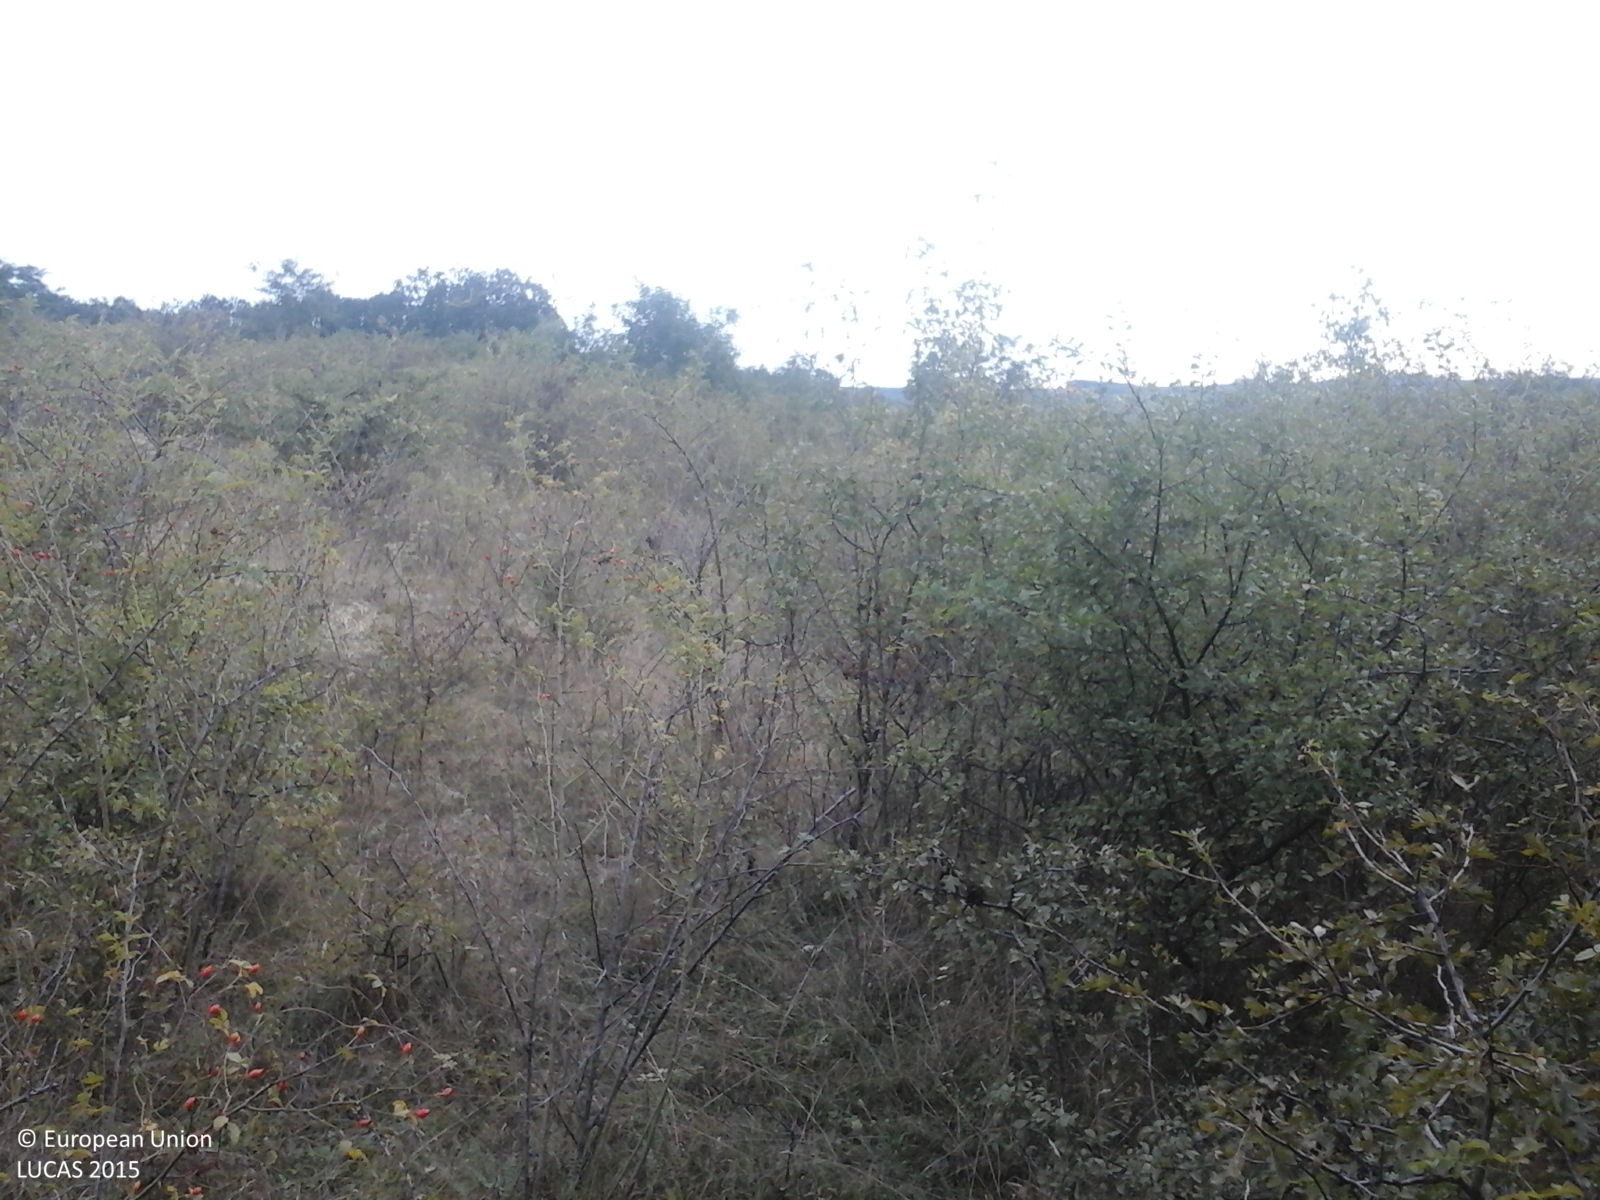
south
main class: Woodland
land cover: Broadleaved woodland
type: exotic forest
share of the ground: > 75 %
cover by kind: broadleaved forest trees 100 %
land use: Forestry
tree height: > 5 m
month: September
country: RO
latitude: 47.4492
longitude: 22.6990
